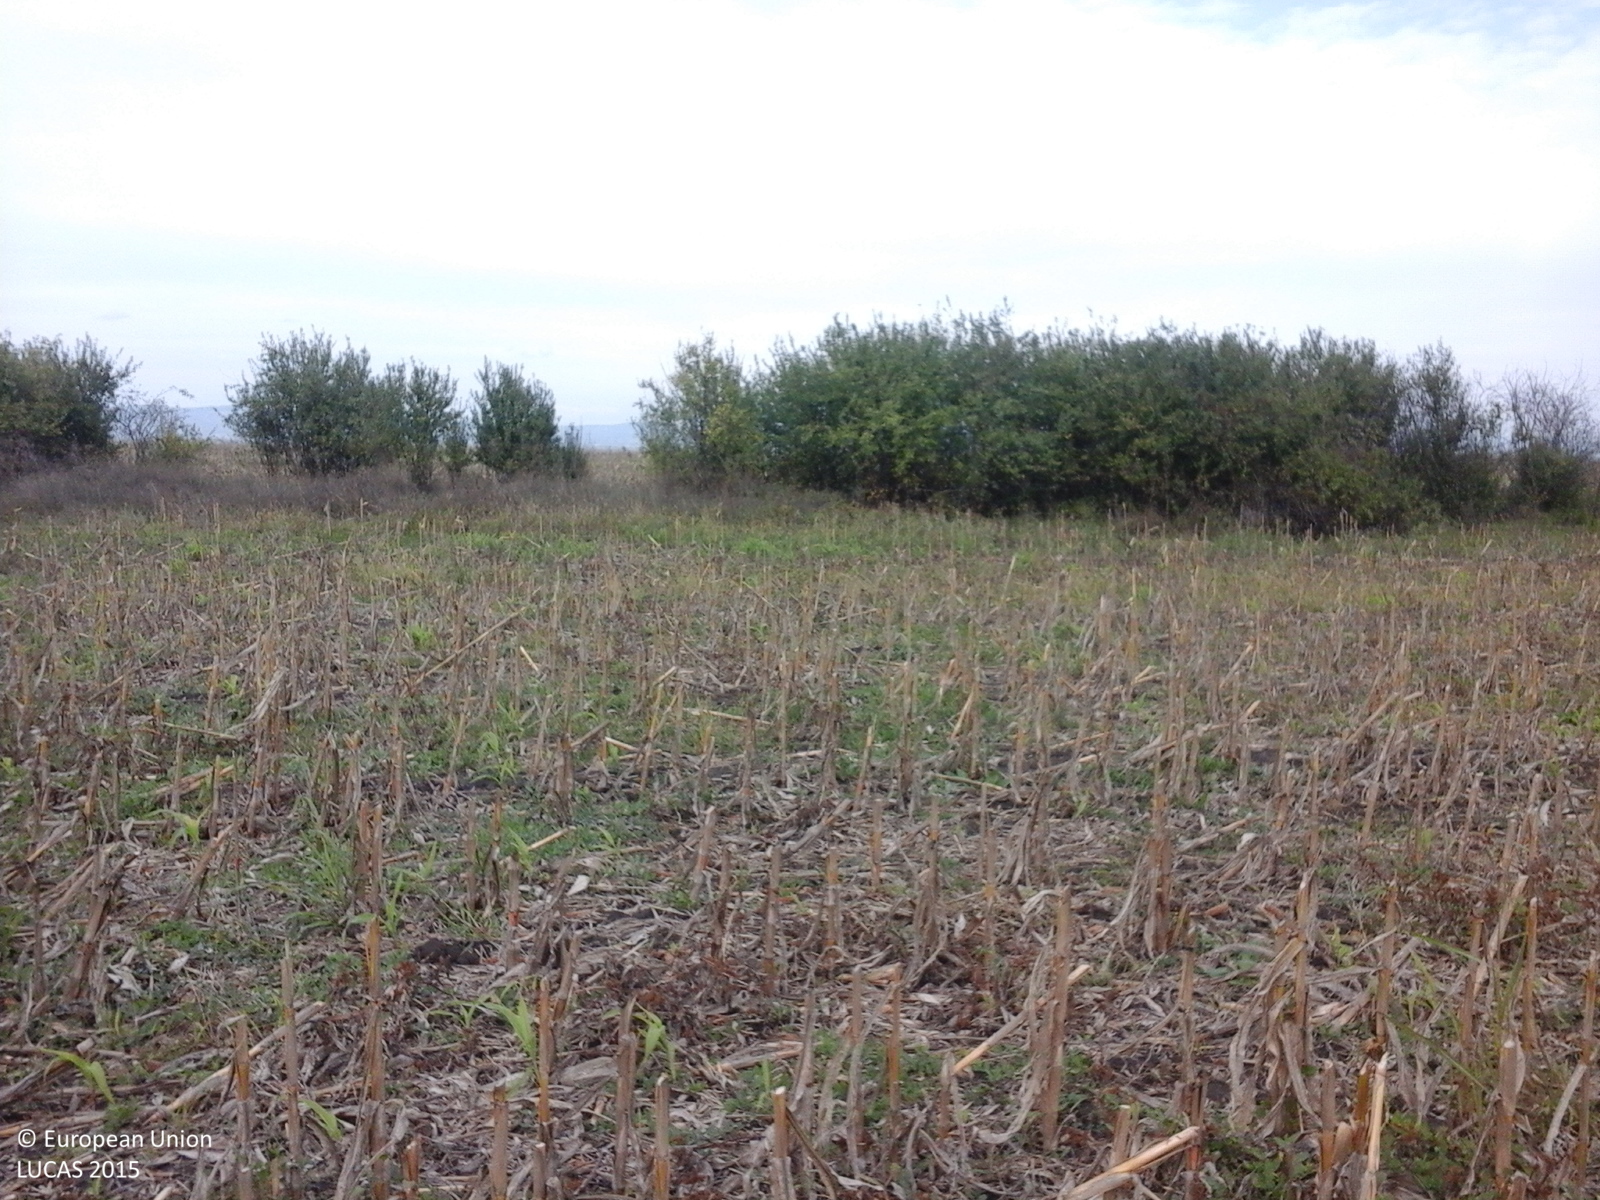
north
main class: Cropland
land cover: Maize
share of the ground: 25 - 50 %
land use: Agriculture (excluding fallow land and kitchen gardens)
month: October
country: RO
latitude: 44.9219
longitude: 26.3186
